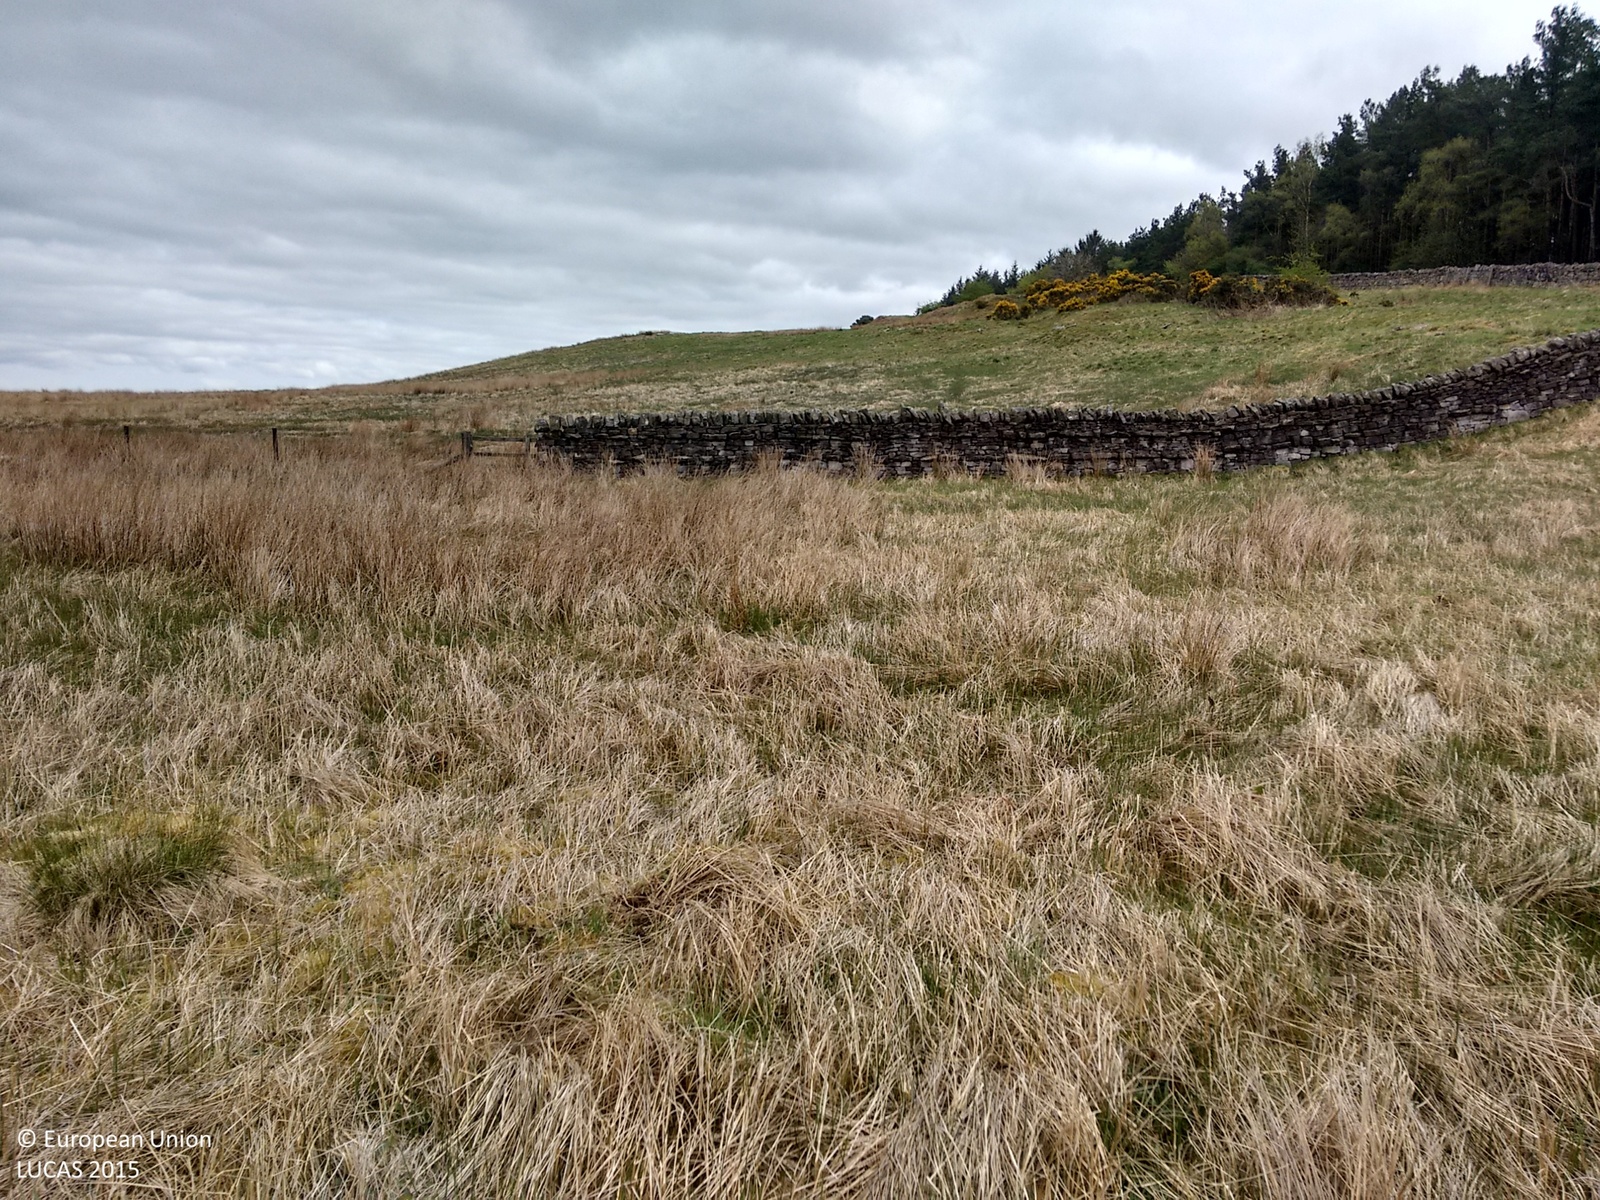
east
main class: Grassland
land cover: Grassland without tree/shrub cover
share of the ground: > 75 %
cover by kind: herbaceous plants 100 %
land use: Agriculture (excluding fallow land and kitchen gardens)
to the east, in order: Grassland without tree/shrub cover; Dry stone walls; Grassland without tree/shrub cover
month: May
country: GB
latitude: 55.0168
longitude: -2.0508
